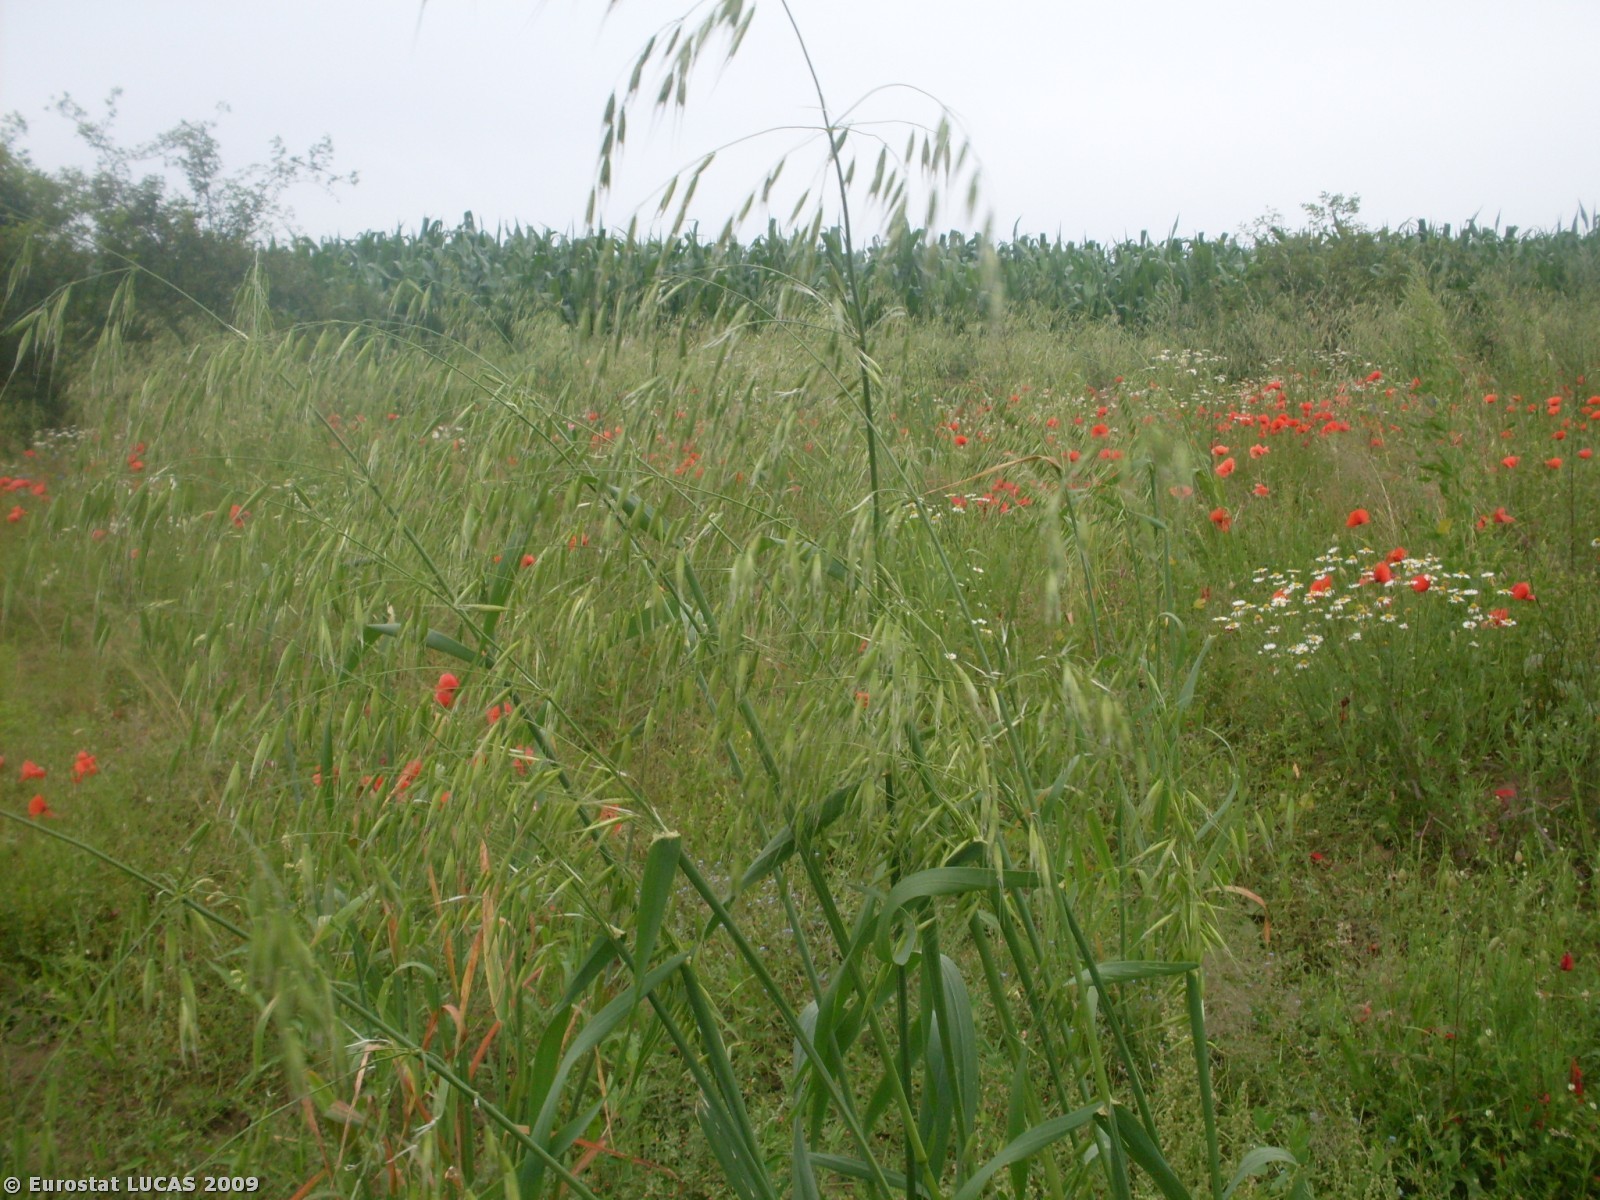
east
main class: Grassland
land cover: Spontaneously vegetated surfaces
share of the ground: > 75 %
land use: Unused
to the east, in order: Spontaneously vegetated surfaces; Abandoned hedges; Maize; Grass margins; Tracks; Shrubland without tree cover; Spontaneously vegetated surfaces; Grassland without tree/shrub cover; Common wheat; Mixed cereals for fodder; Grass margins; Rape and turnip rape; Grassland with sparse tree/shrub cover; Fences; Grassland with sparse tree/shrub cover; Tracks; Artificial constructions in urban areas; Fences
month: July
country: PL
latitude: 50.1825
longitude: 20.5557
